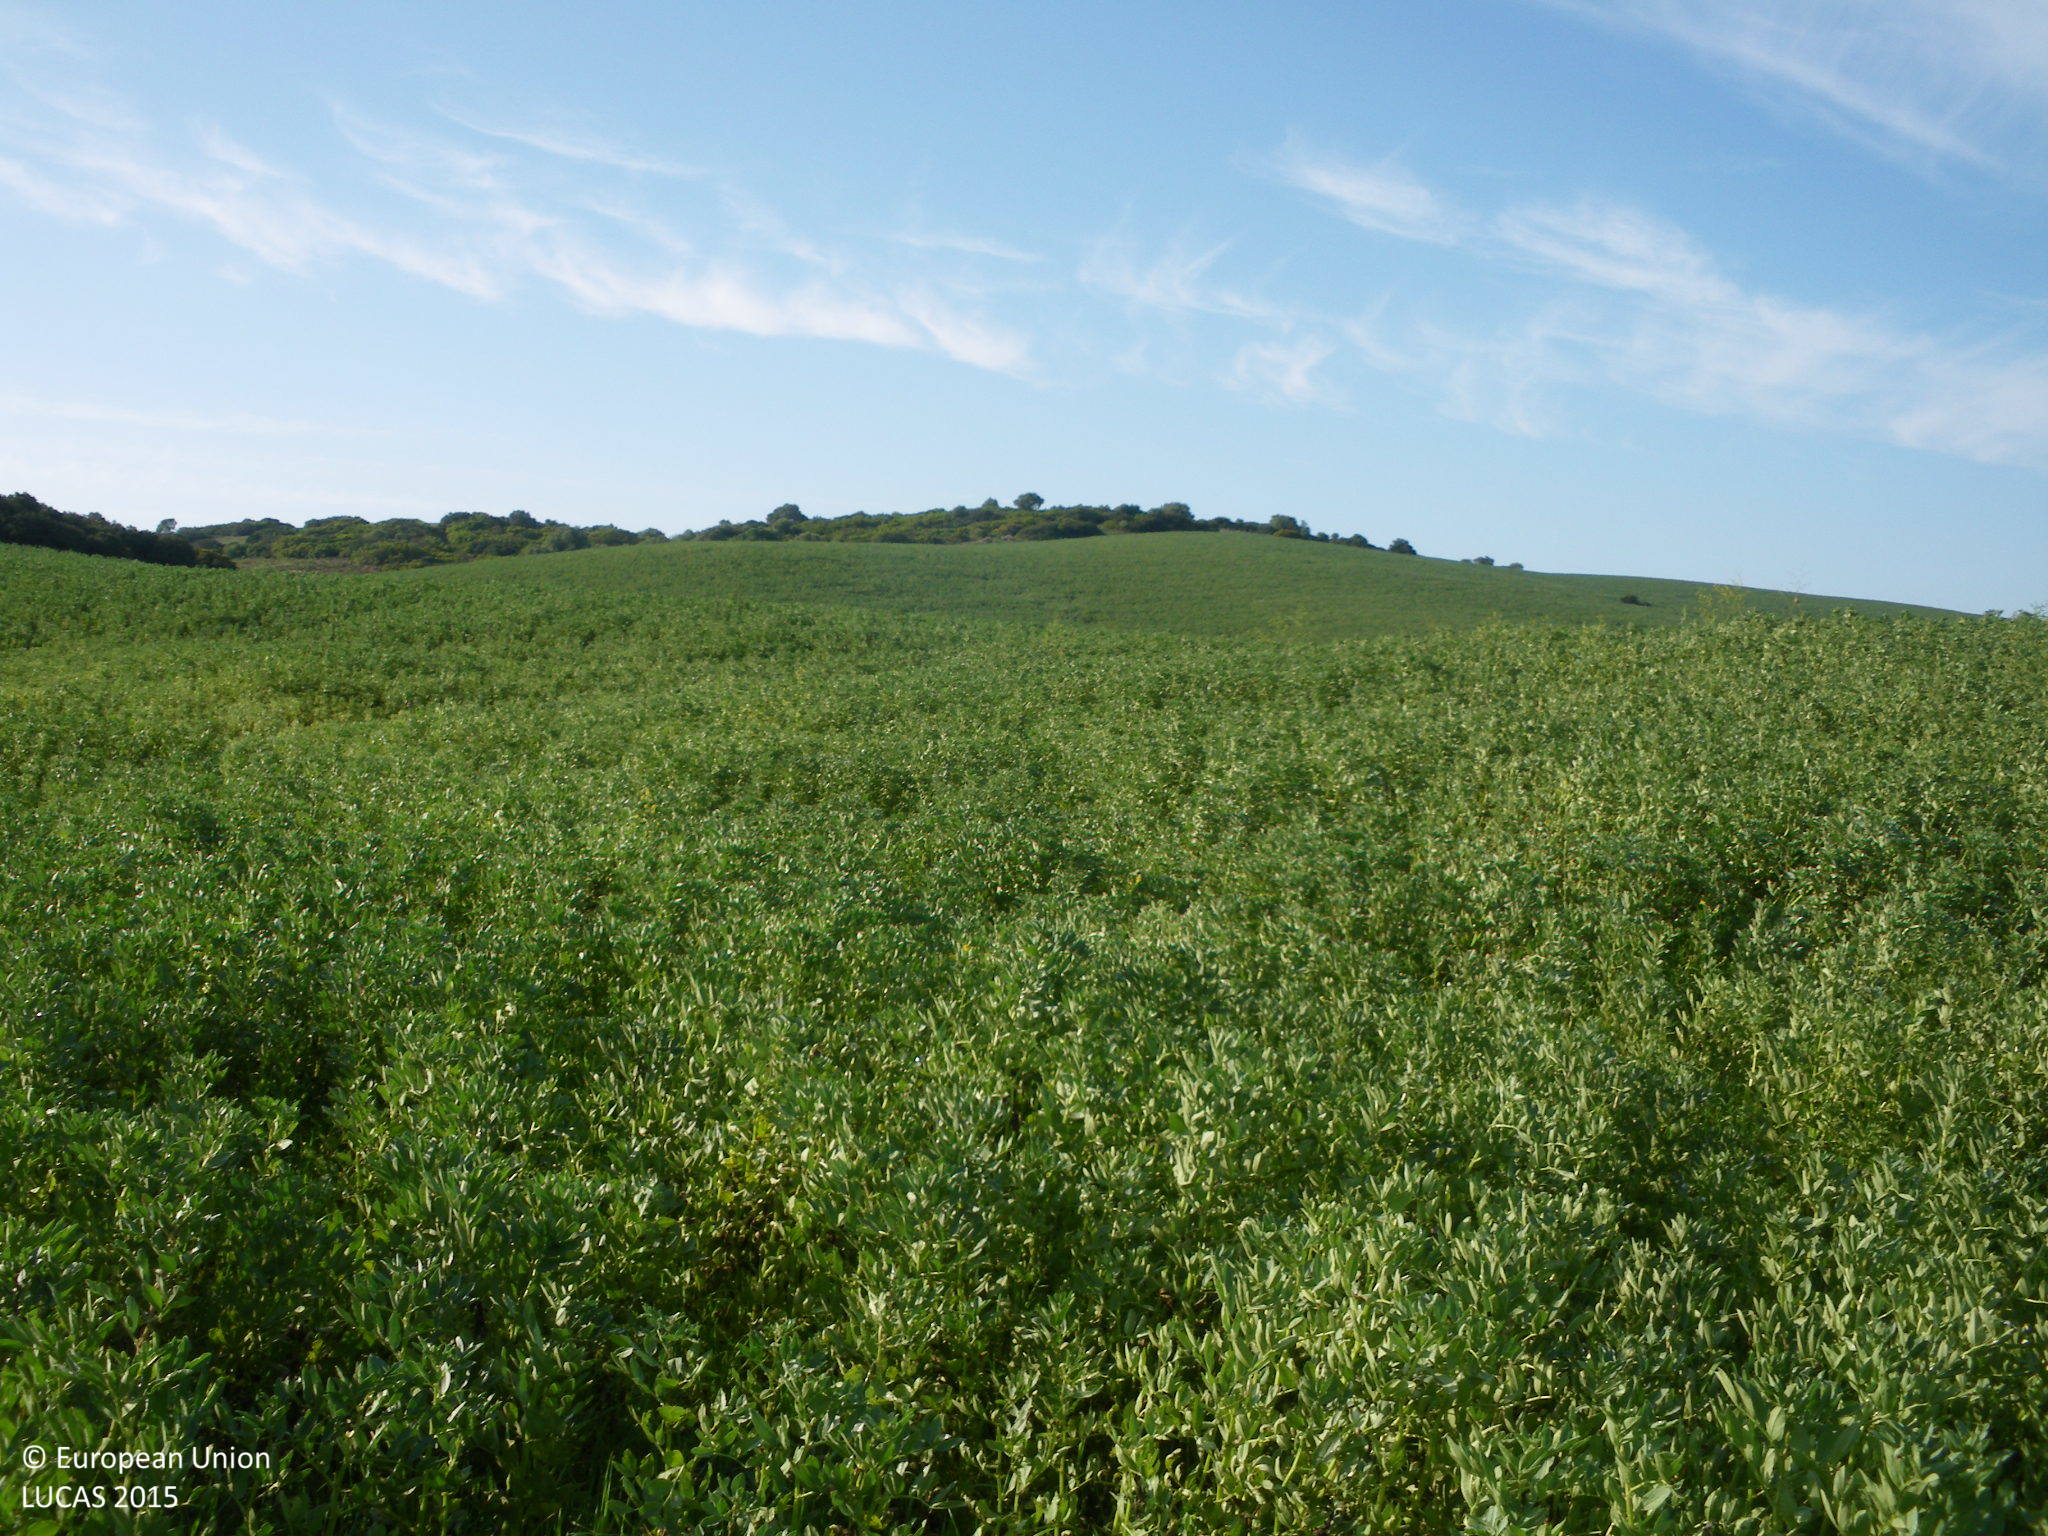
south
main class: Cropland
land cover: Dry pulses
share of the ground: 25 - 50 %
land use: Agriculture (excluding fallow land and kitchen gardens)
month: April
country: ES
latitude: 36.4831
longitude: -5.9557
